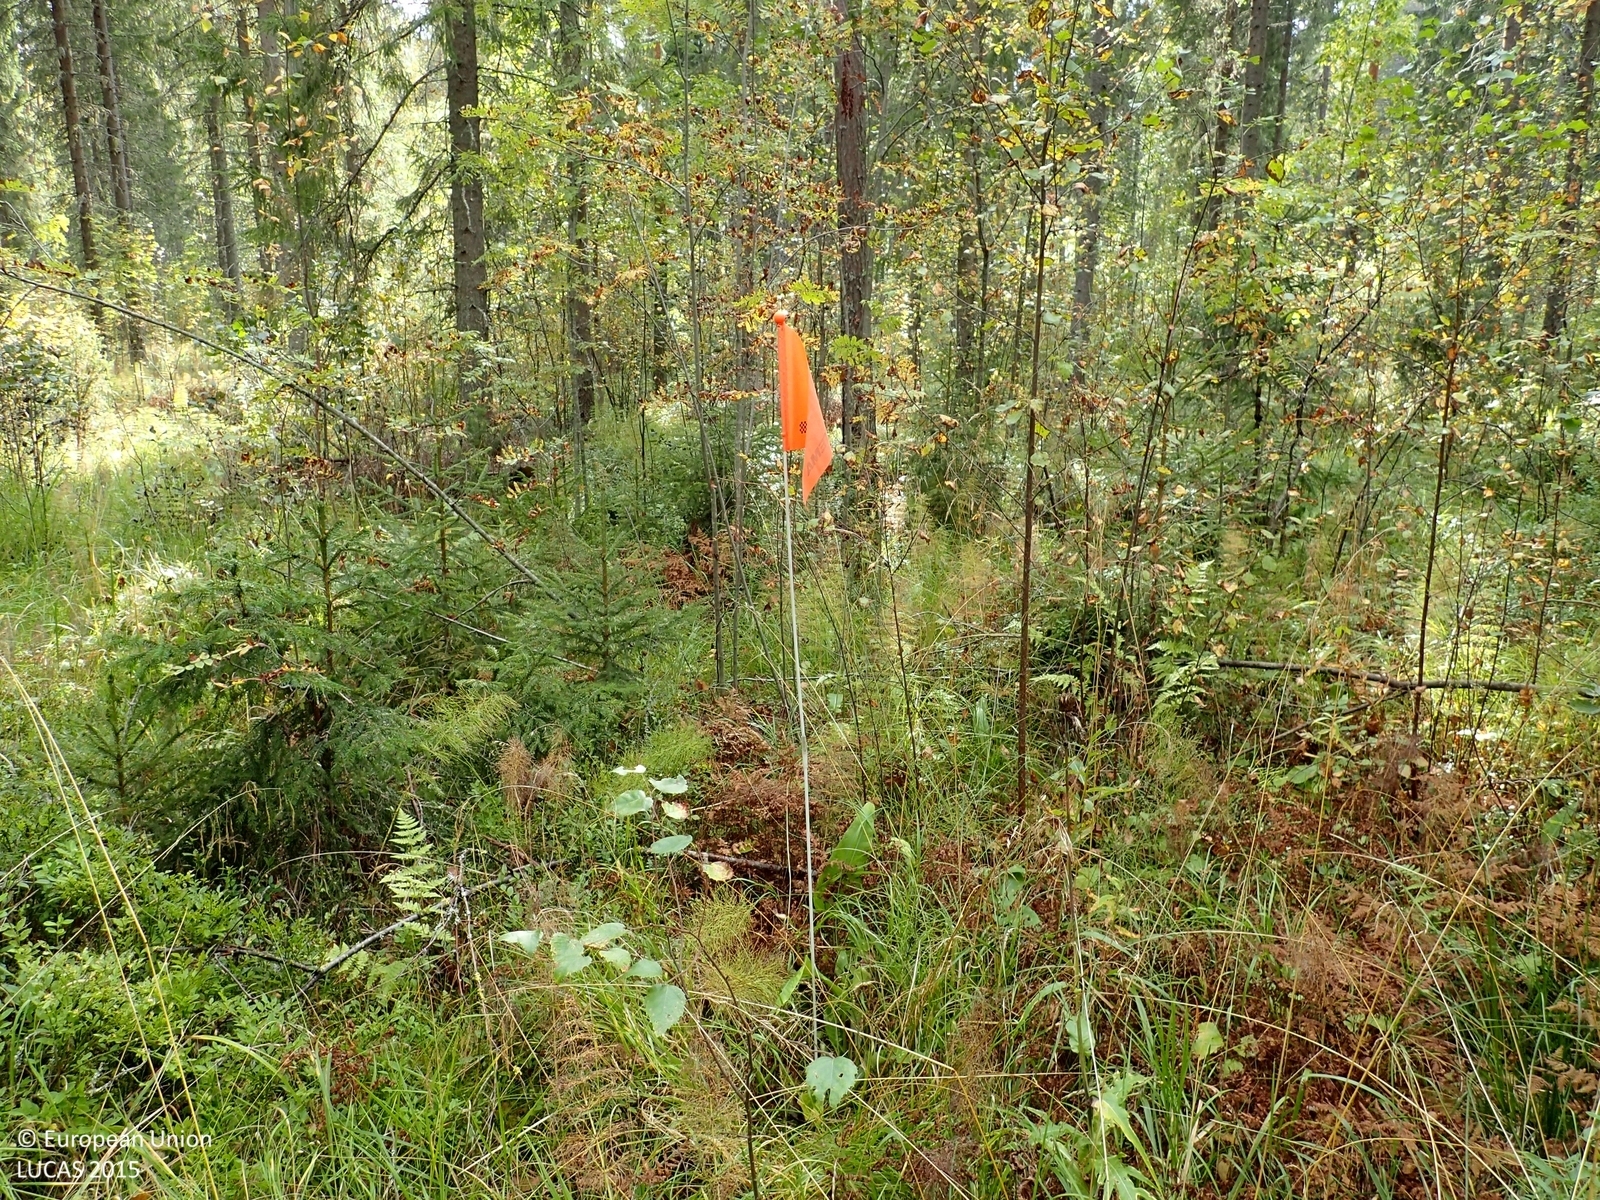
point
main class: Woodland
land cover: Pine dominated mixed woodland
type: boreal forest
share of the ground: > 75 %
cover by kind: coniferous forest trees 55 %, broadleaved forest trees 20 %, herbaceous plants 15 %, shrubs 10 %
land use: Forestry
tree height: > 5 m
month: September
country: FI
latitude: 63.0362
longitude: 25.3439
